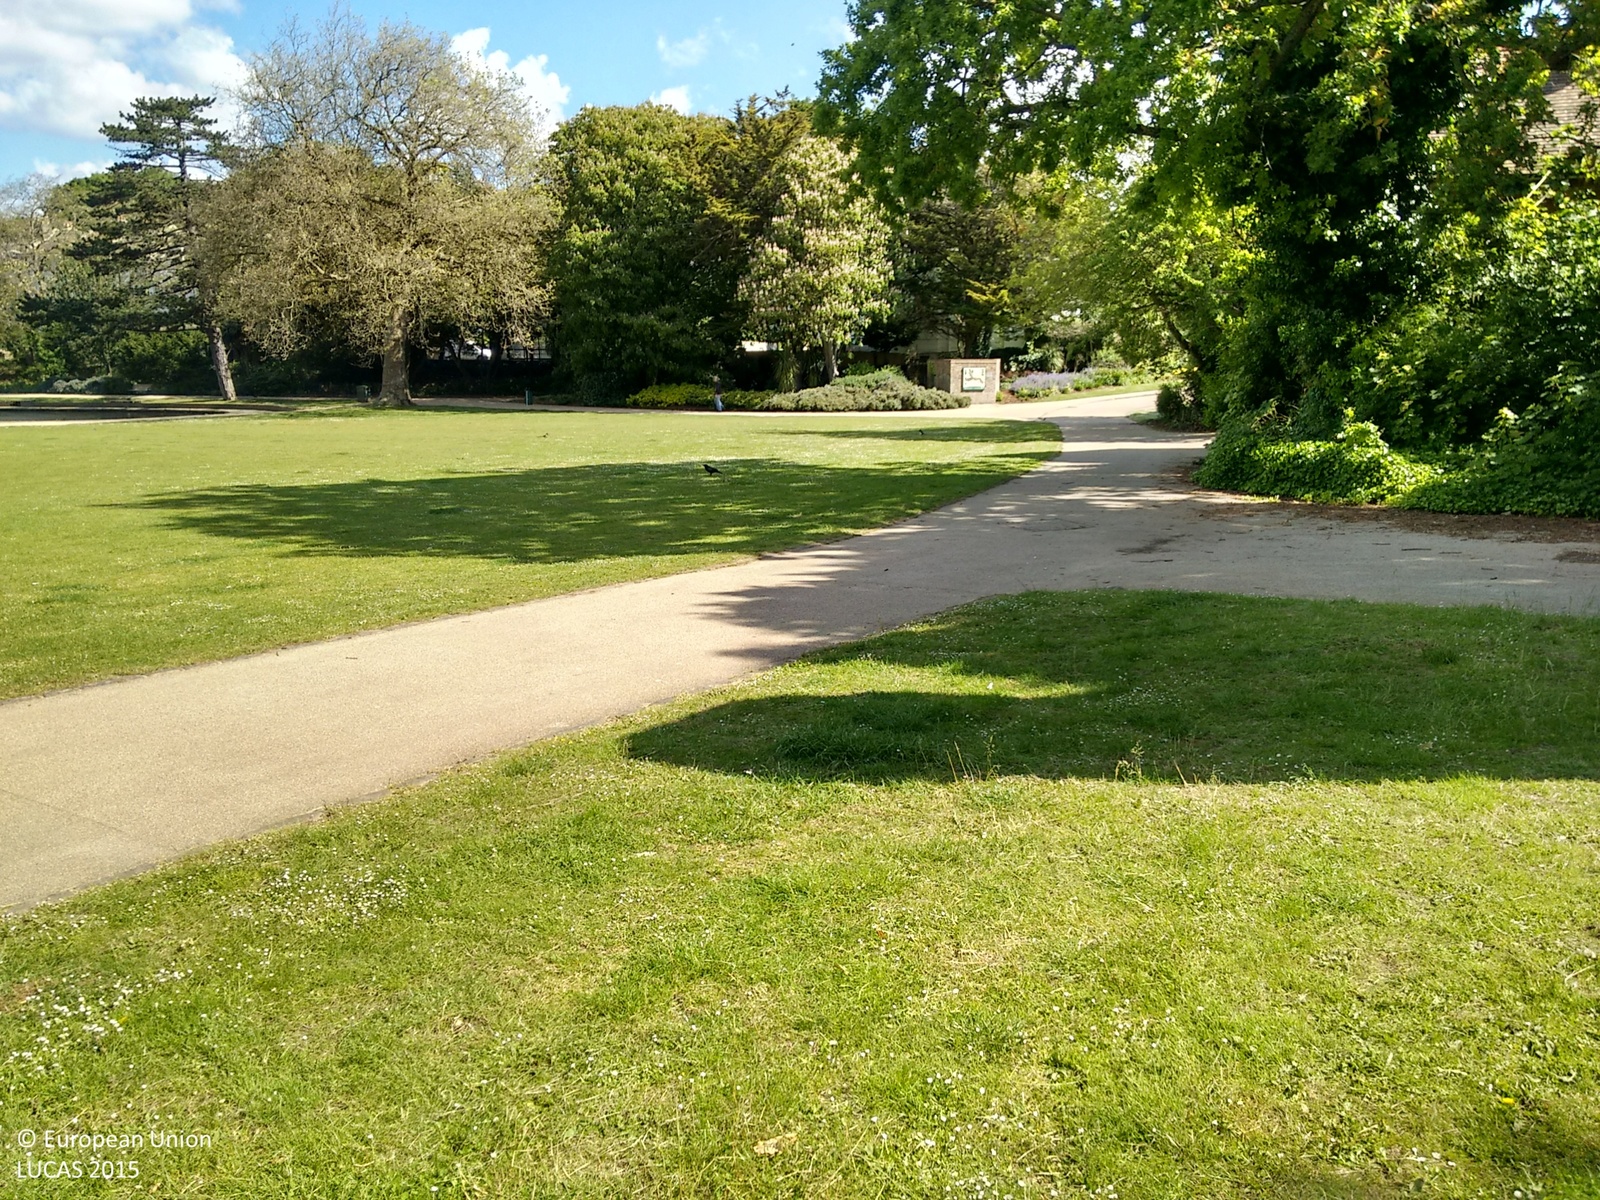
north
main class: Grassland
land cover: Grassland without tree/shrub cover
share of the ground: > 75 %
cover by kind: herbaceous plants 100 %
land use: Amenities, museums, leisure
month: June
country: GB
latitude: 50.8618
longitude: 0.5819
